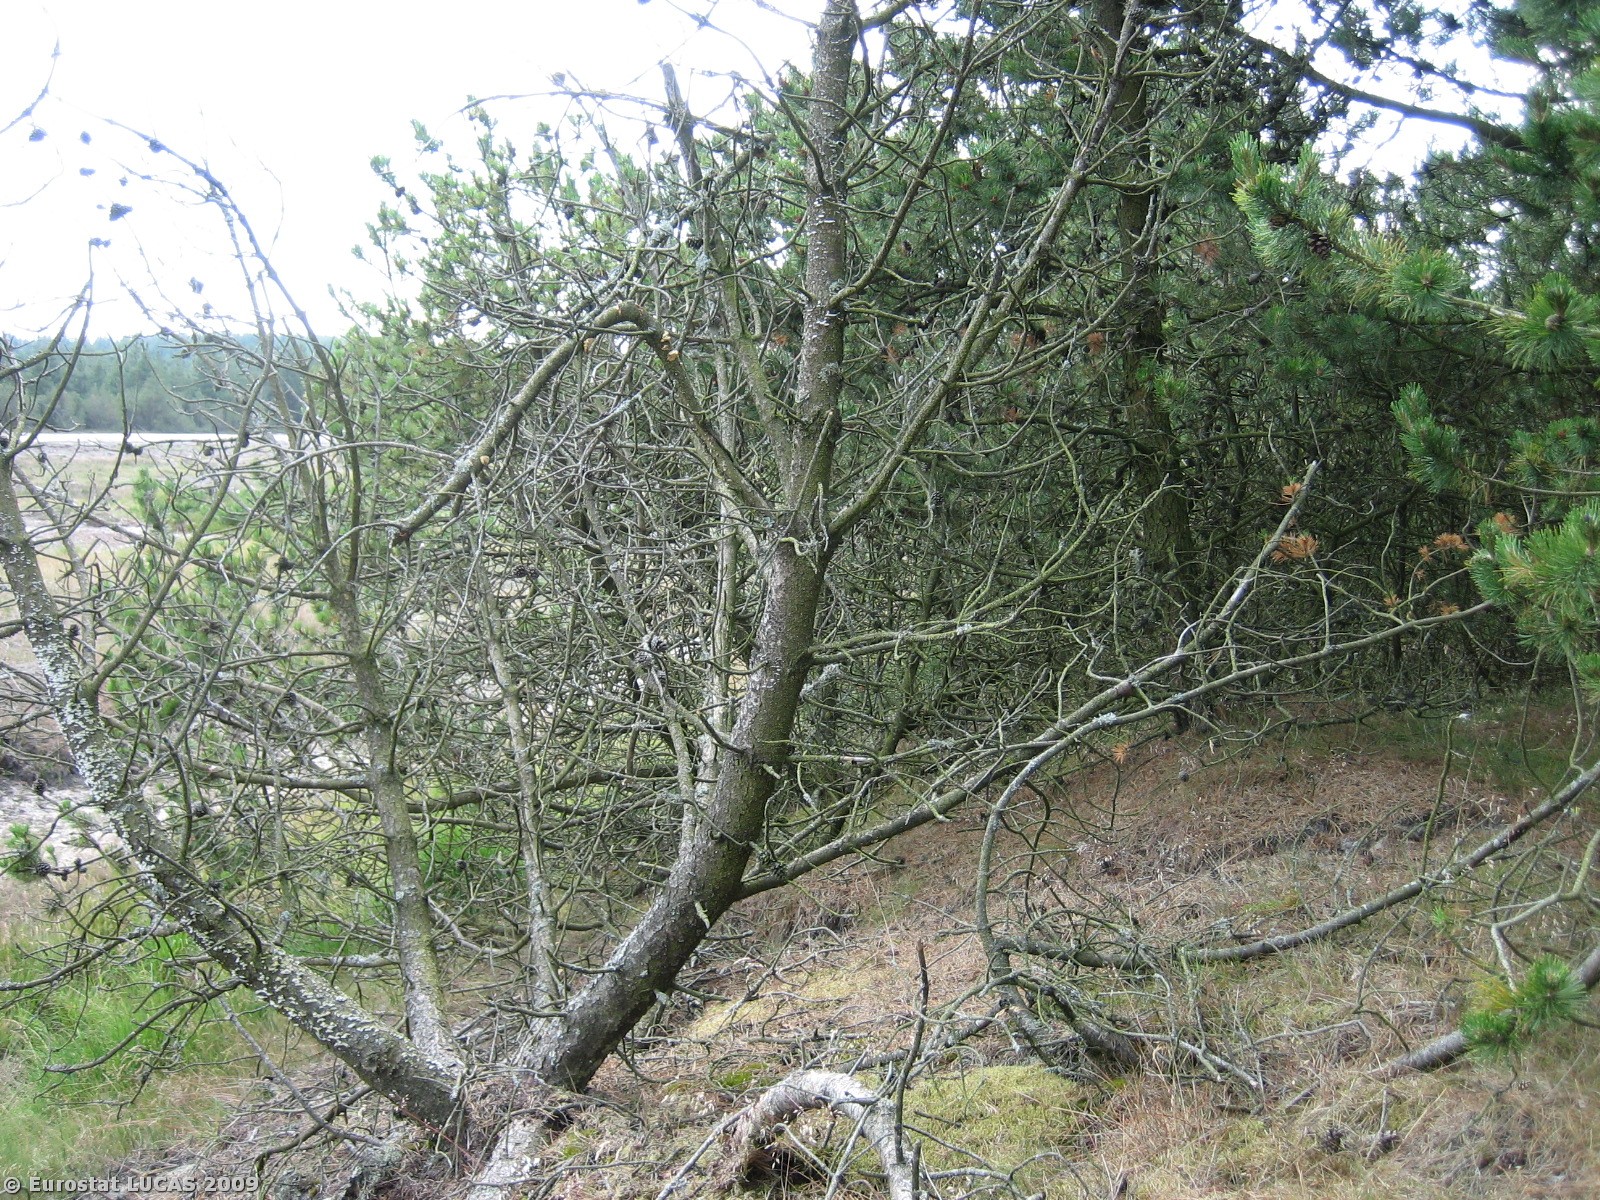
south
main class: Woodland
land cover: Coniferous woodland
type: hemiboreal forest and nemoral coniferous forest and mixed broadleaved-coniferous forest
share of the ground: 50 - 75 %
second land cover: Bare land
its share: 10 - 25 %
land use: Forestry
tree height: > 5 m
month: July
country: DK
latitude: 55.7621
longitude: 8.2327
